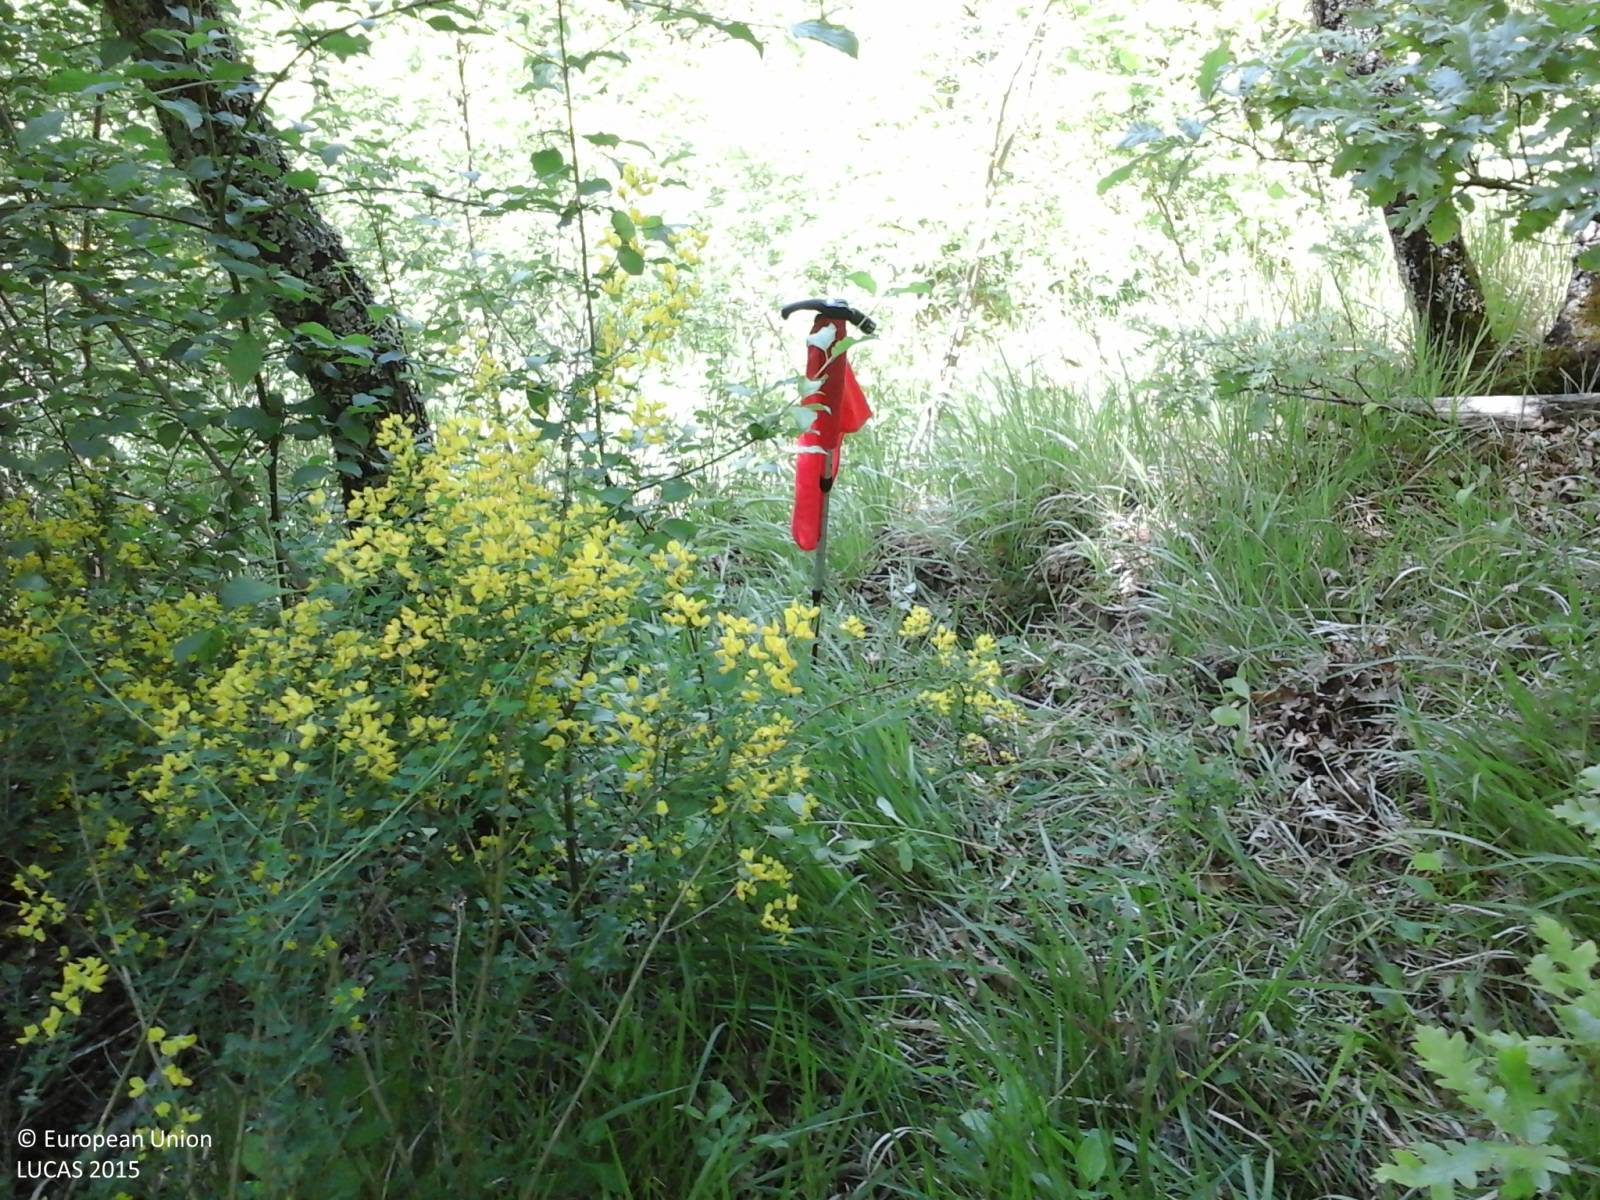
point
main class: Woodland
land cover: Broadleaved woodland
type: thermophilous deciduous forest
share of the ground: > 75 %
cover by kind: broadleaved forest trees 90 %, shrubs 5 %, herbaceous plants 5 %
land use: Forestry
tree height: > 5 m
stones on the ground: < 10 %
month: May
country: IT
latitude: 42.1148
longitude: 13.2182
